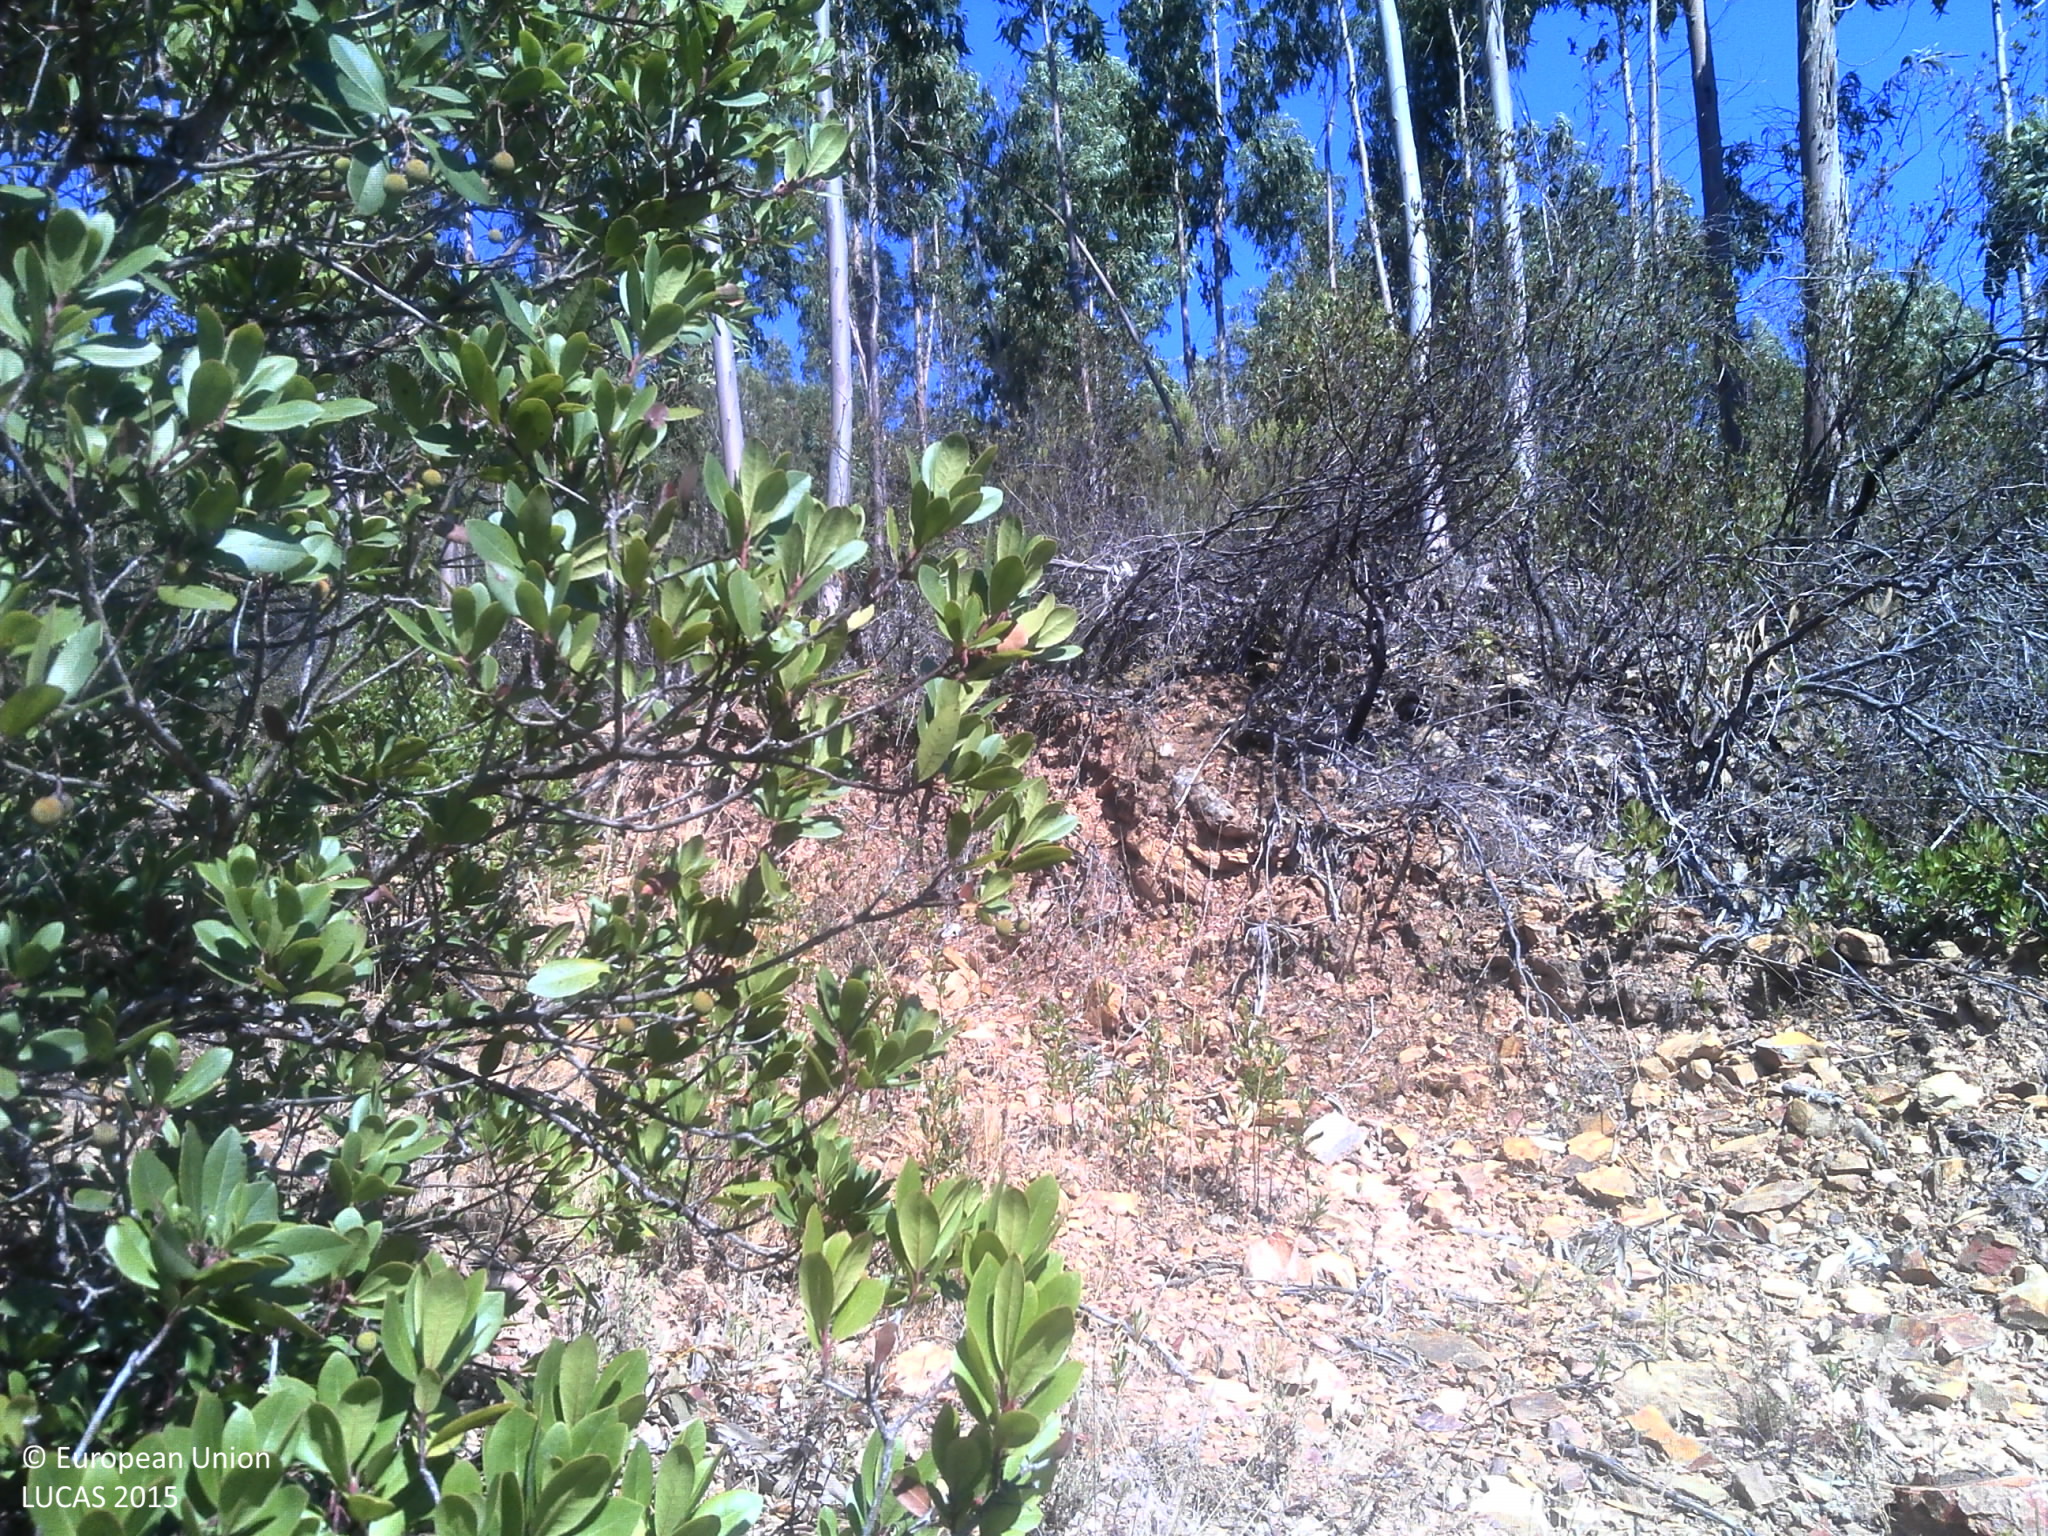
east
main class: Woodland
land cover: Broadleaved woodland
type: broadleaved evergreen forest
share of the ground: 25 - 50 %
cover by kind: broadleaved forest trees 40 %, shrubs 20 %, herbaceous plants 20 %, unconsolidated bare surface 20 %
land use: Forestry
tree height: > 5 m
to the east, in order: Broadleaved woodland; Tracks; Broadleaved woodland; Tracks; Broadleaved woodland; Tracks; Broadleaved woodland; Tracks; Broadleaved woodland
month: August
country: PT
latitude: 37.4070
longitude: -8.7337
